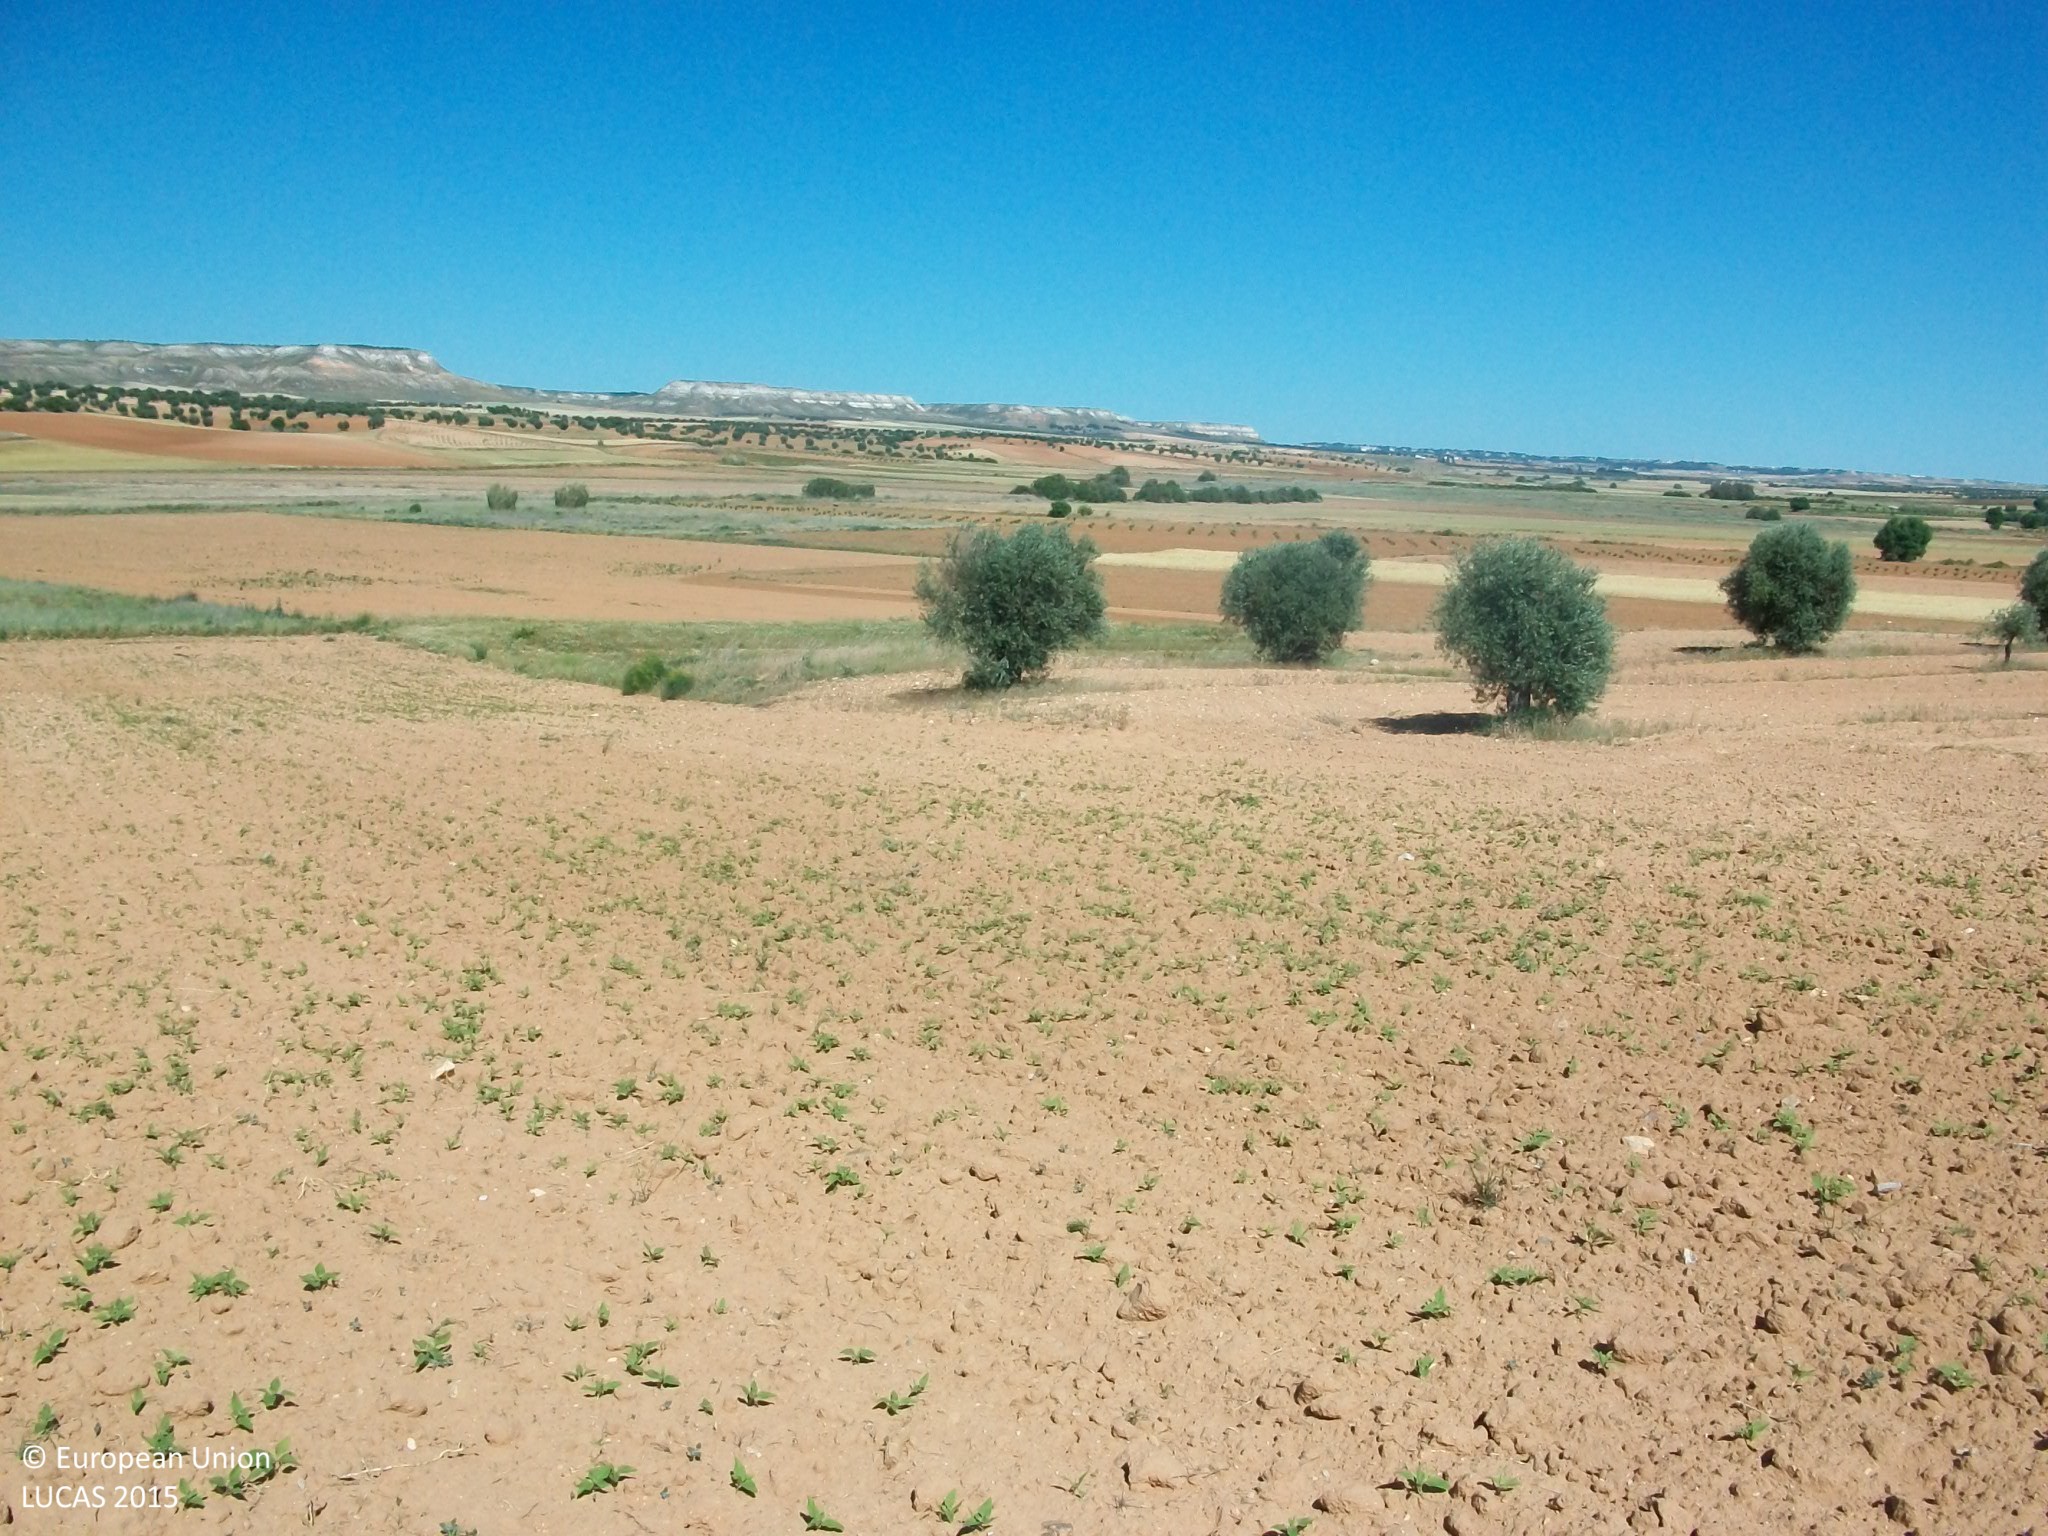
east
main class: Cropland
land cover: Dry pulses
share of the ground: < 10 %
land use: Agriculture (excluding fallow land and kitchen gardens)
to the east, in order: Dry pulses; Shruby margins; Spontaneously vegetated surfaces; Grass margins; Tracks; Grass margins; Other bare soil; Grass margins; Other bare soil; Grass margins; Other bare soil; Grass margins; Spontaneously vegetated surfaces
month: May
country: ES
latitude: 39.8261
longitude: -3.6167
